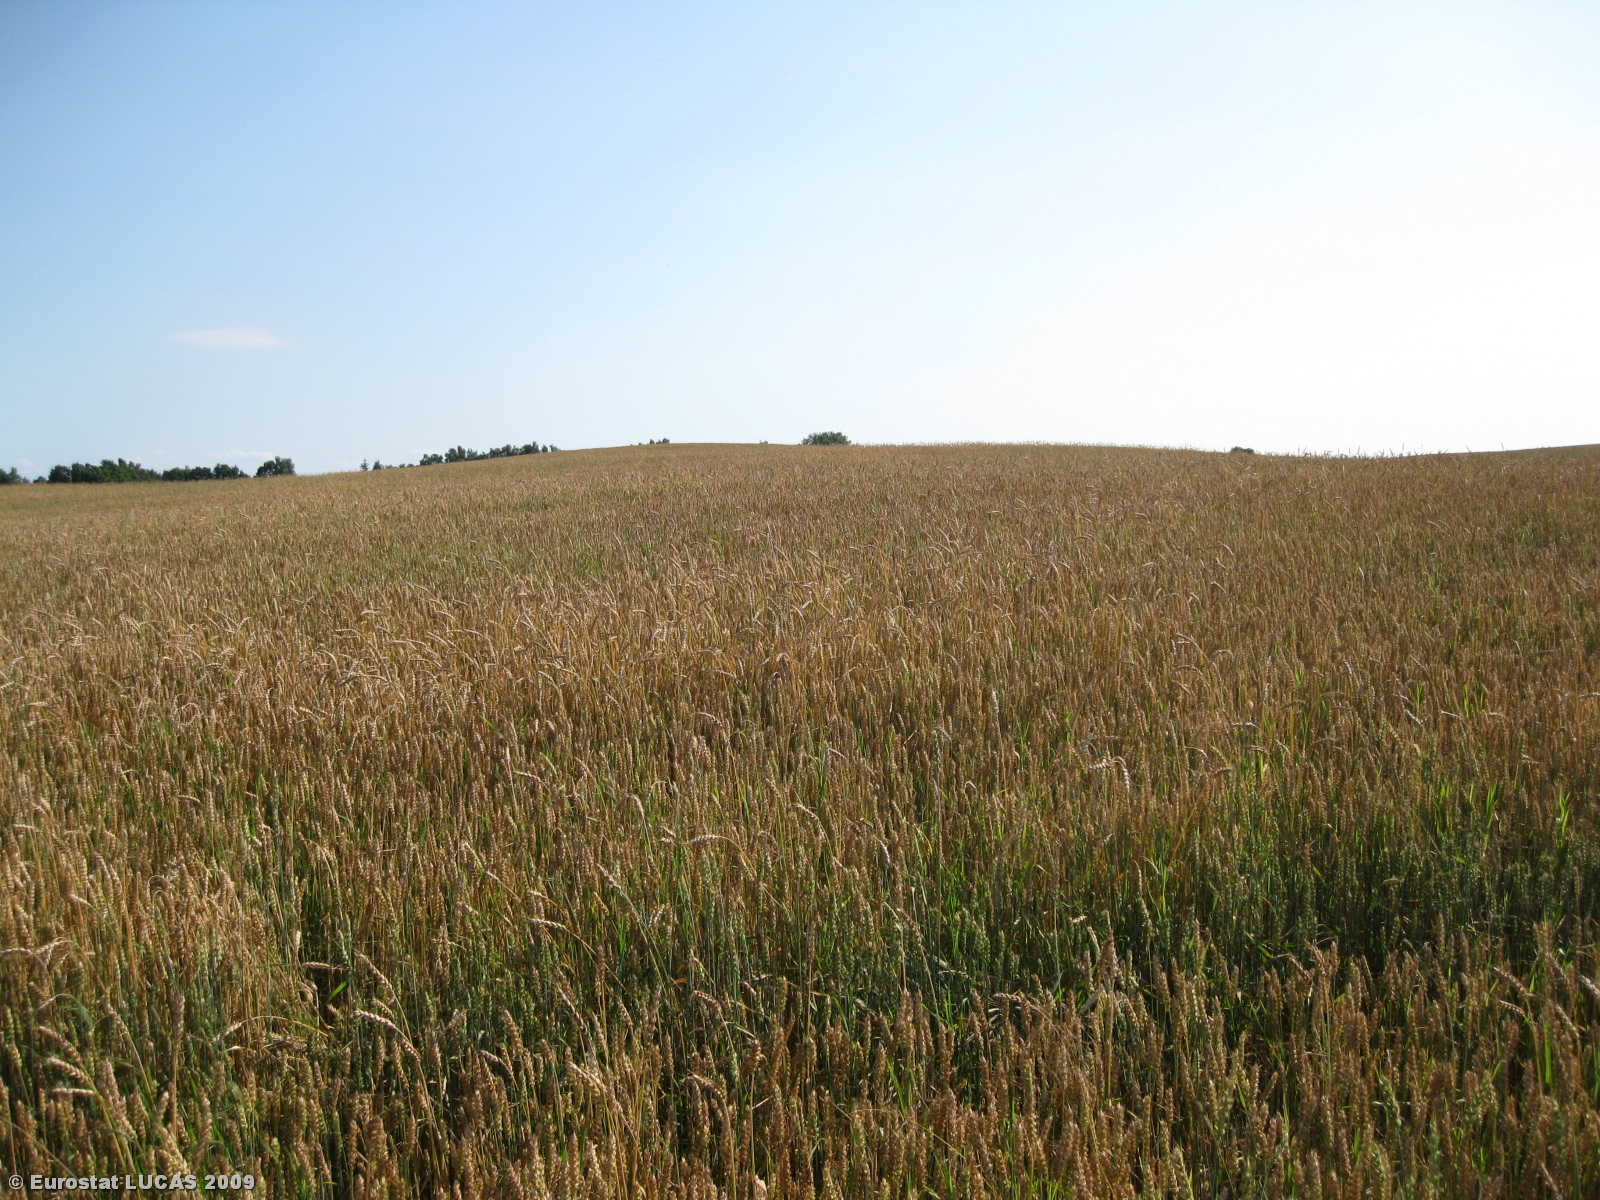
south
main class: Cropland
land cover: Common wheat
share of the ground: > 75 %
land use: Agriculture (excluding fallow land and kitchen gardens)
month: July
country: LT
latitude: 54.4066
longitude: 23.3753
